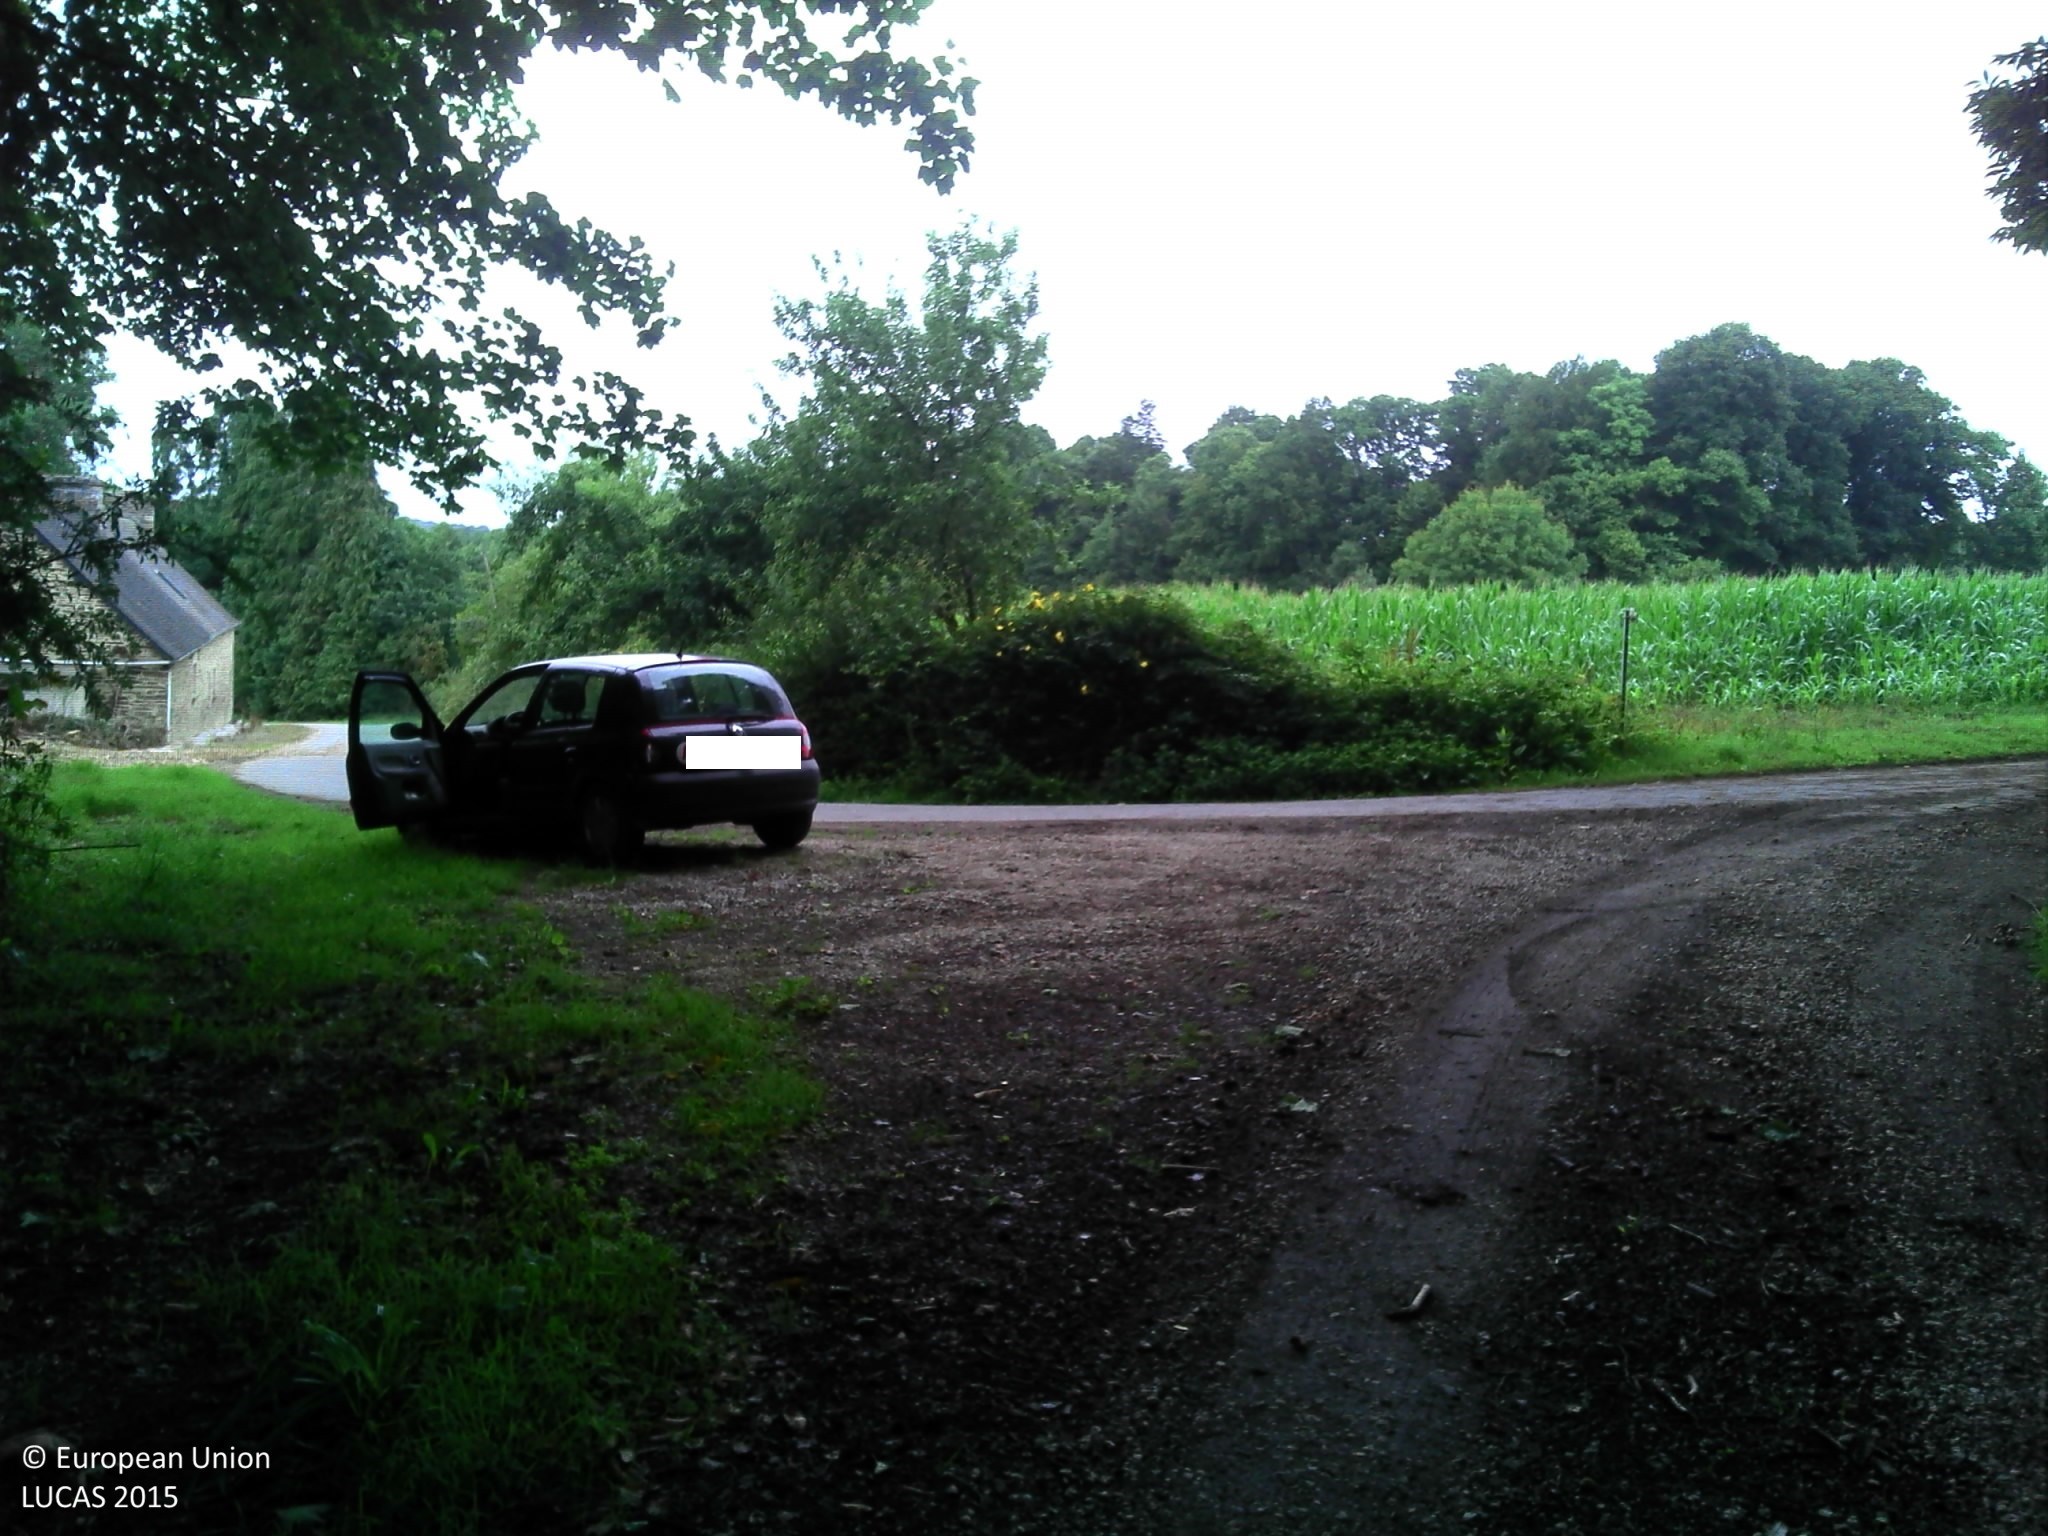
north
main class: Woodland
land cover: Broadleaved woodland
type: mesophytic deciduous forest
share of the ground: > 75 %
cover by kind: broadleaved forest trees 90 %, herbaceous plants 10 %
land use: Forestry
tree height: > 5 m
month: July
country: FR
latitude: 48.2199
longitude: -3.1133
